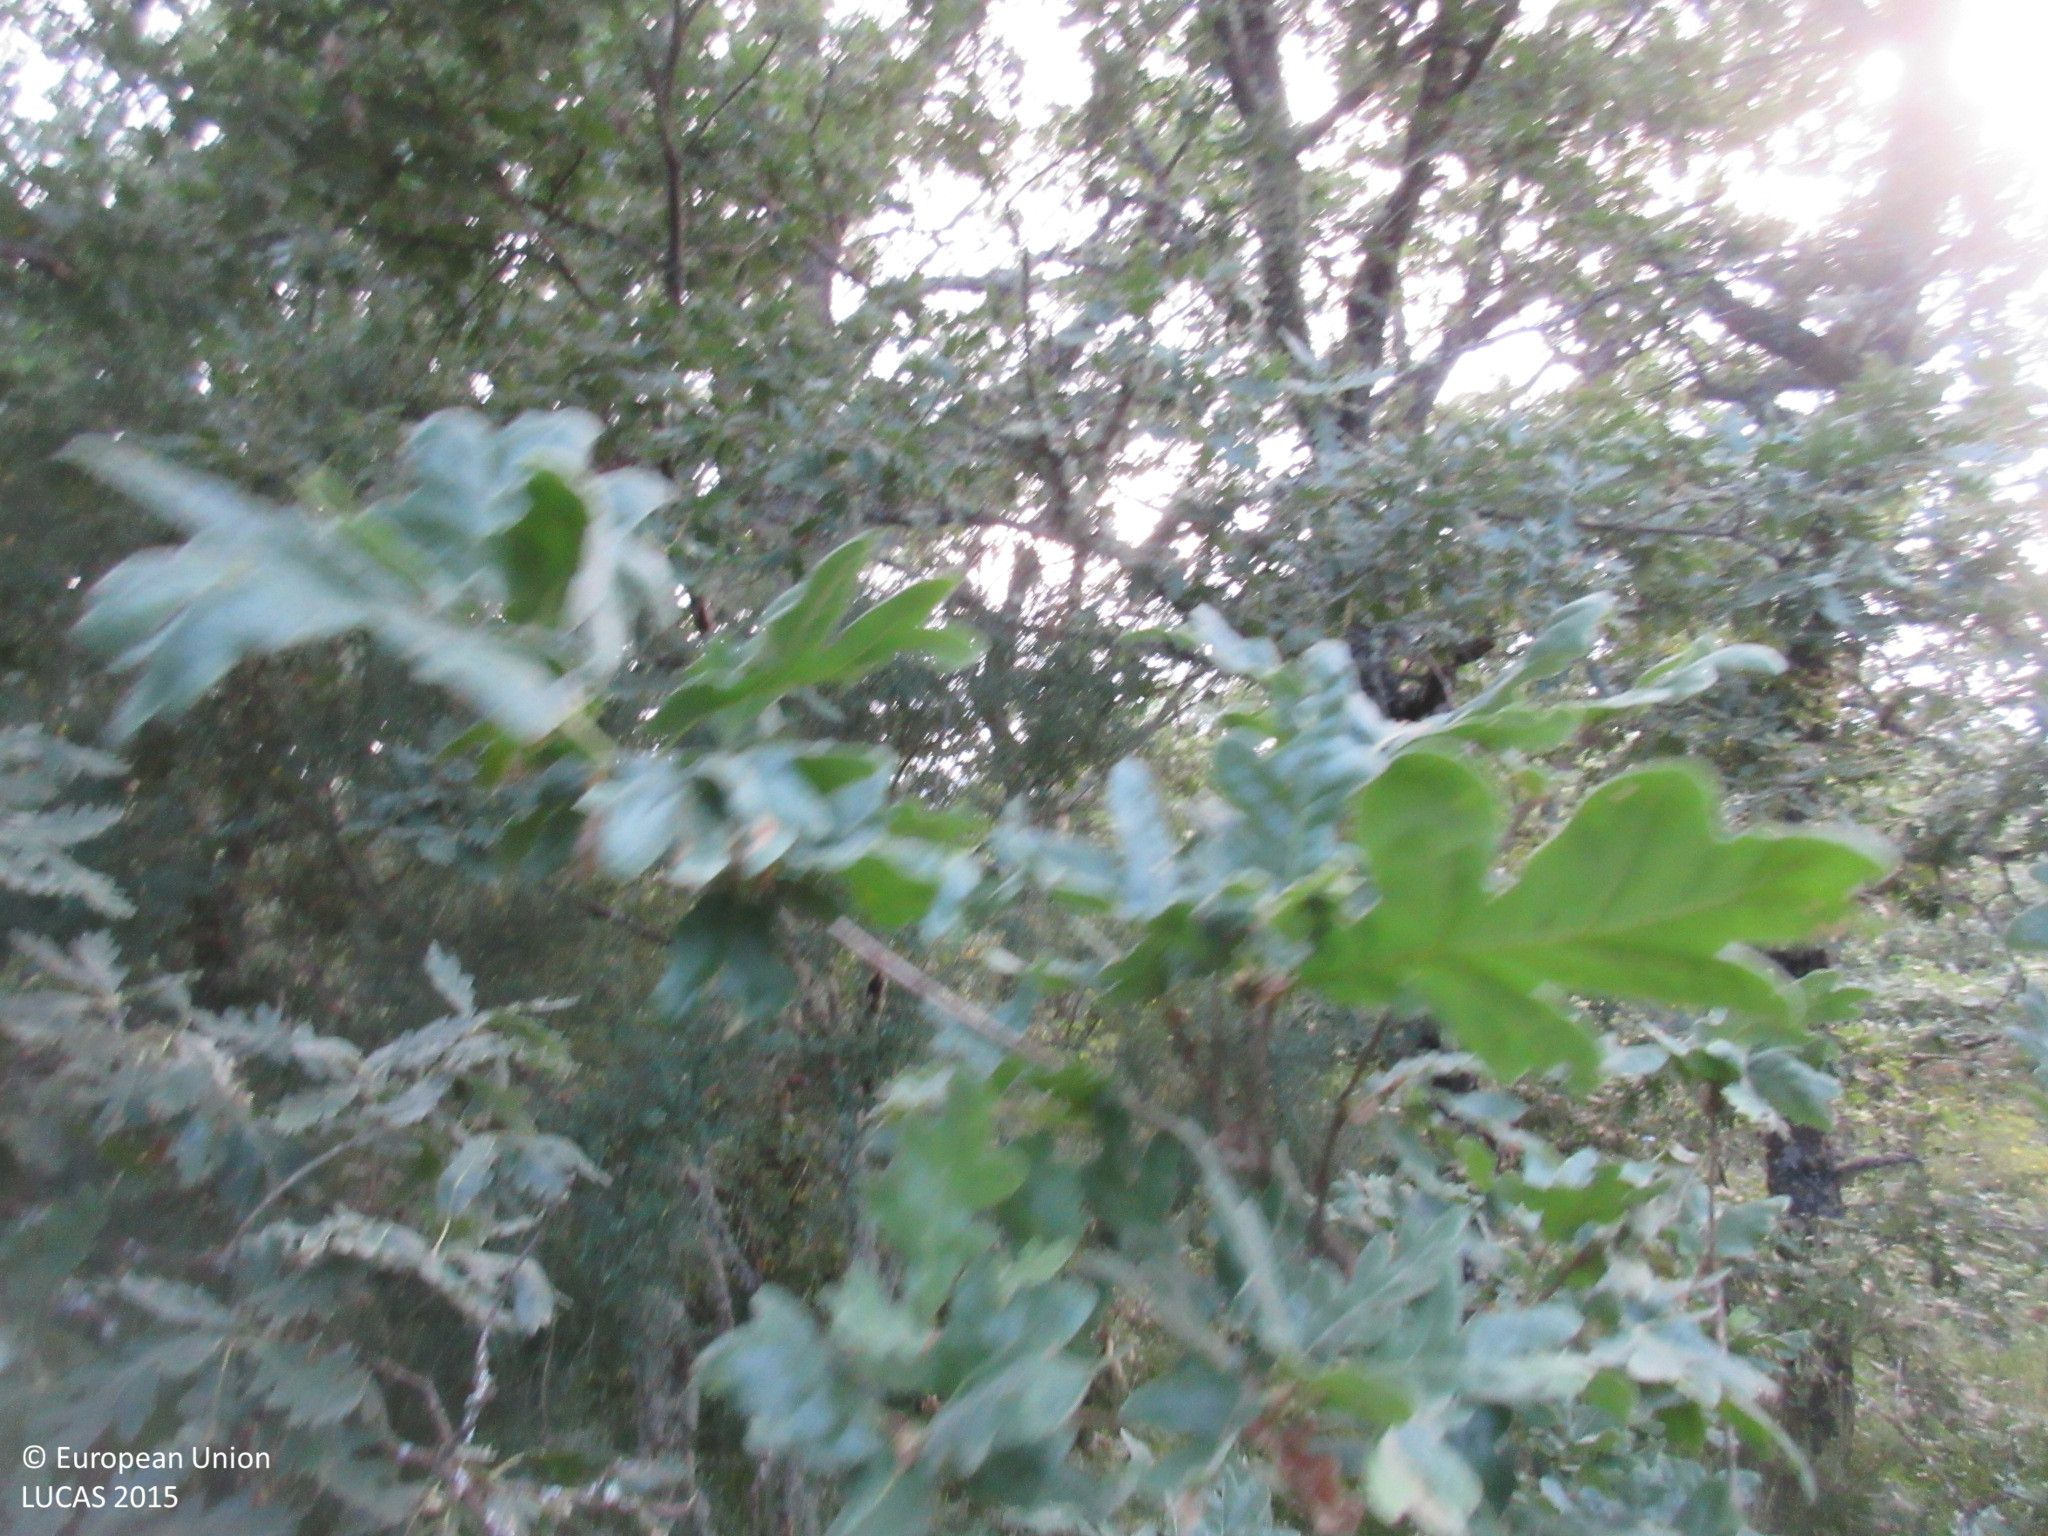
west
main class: Woodland
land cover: Broadleaved woodland
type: acidophilous oak and oak-birch forest
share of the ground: > 75 %
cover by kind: broadleaved forest trees 90 %, shrubs 10 %
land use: Semi-natural and natural areas not in use
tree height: > 5 m
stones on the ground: 10 - 25 %
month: July
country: ES
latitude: 42.8769
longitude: -4.4388
